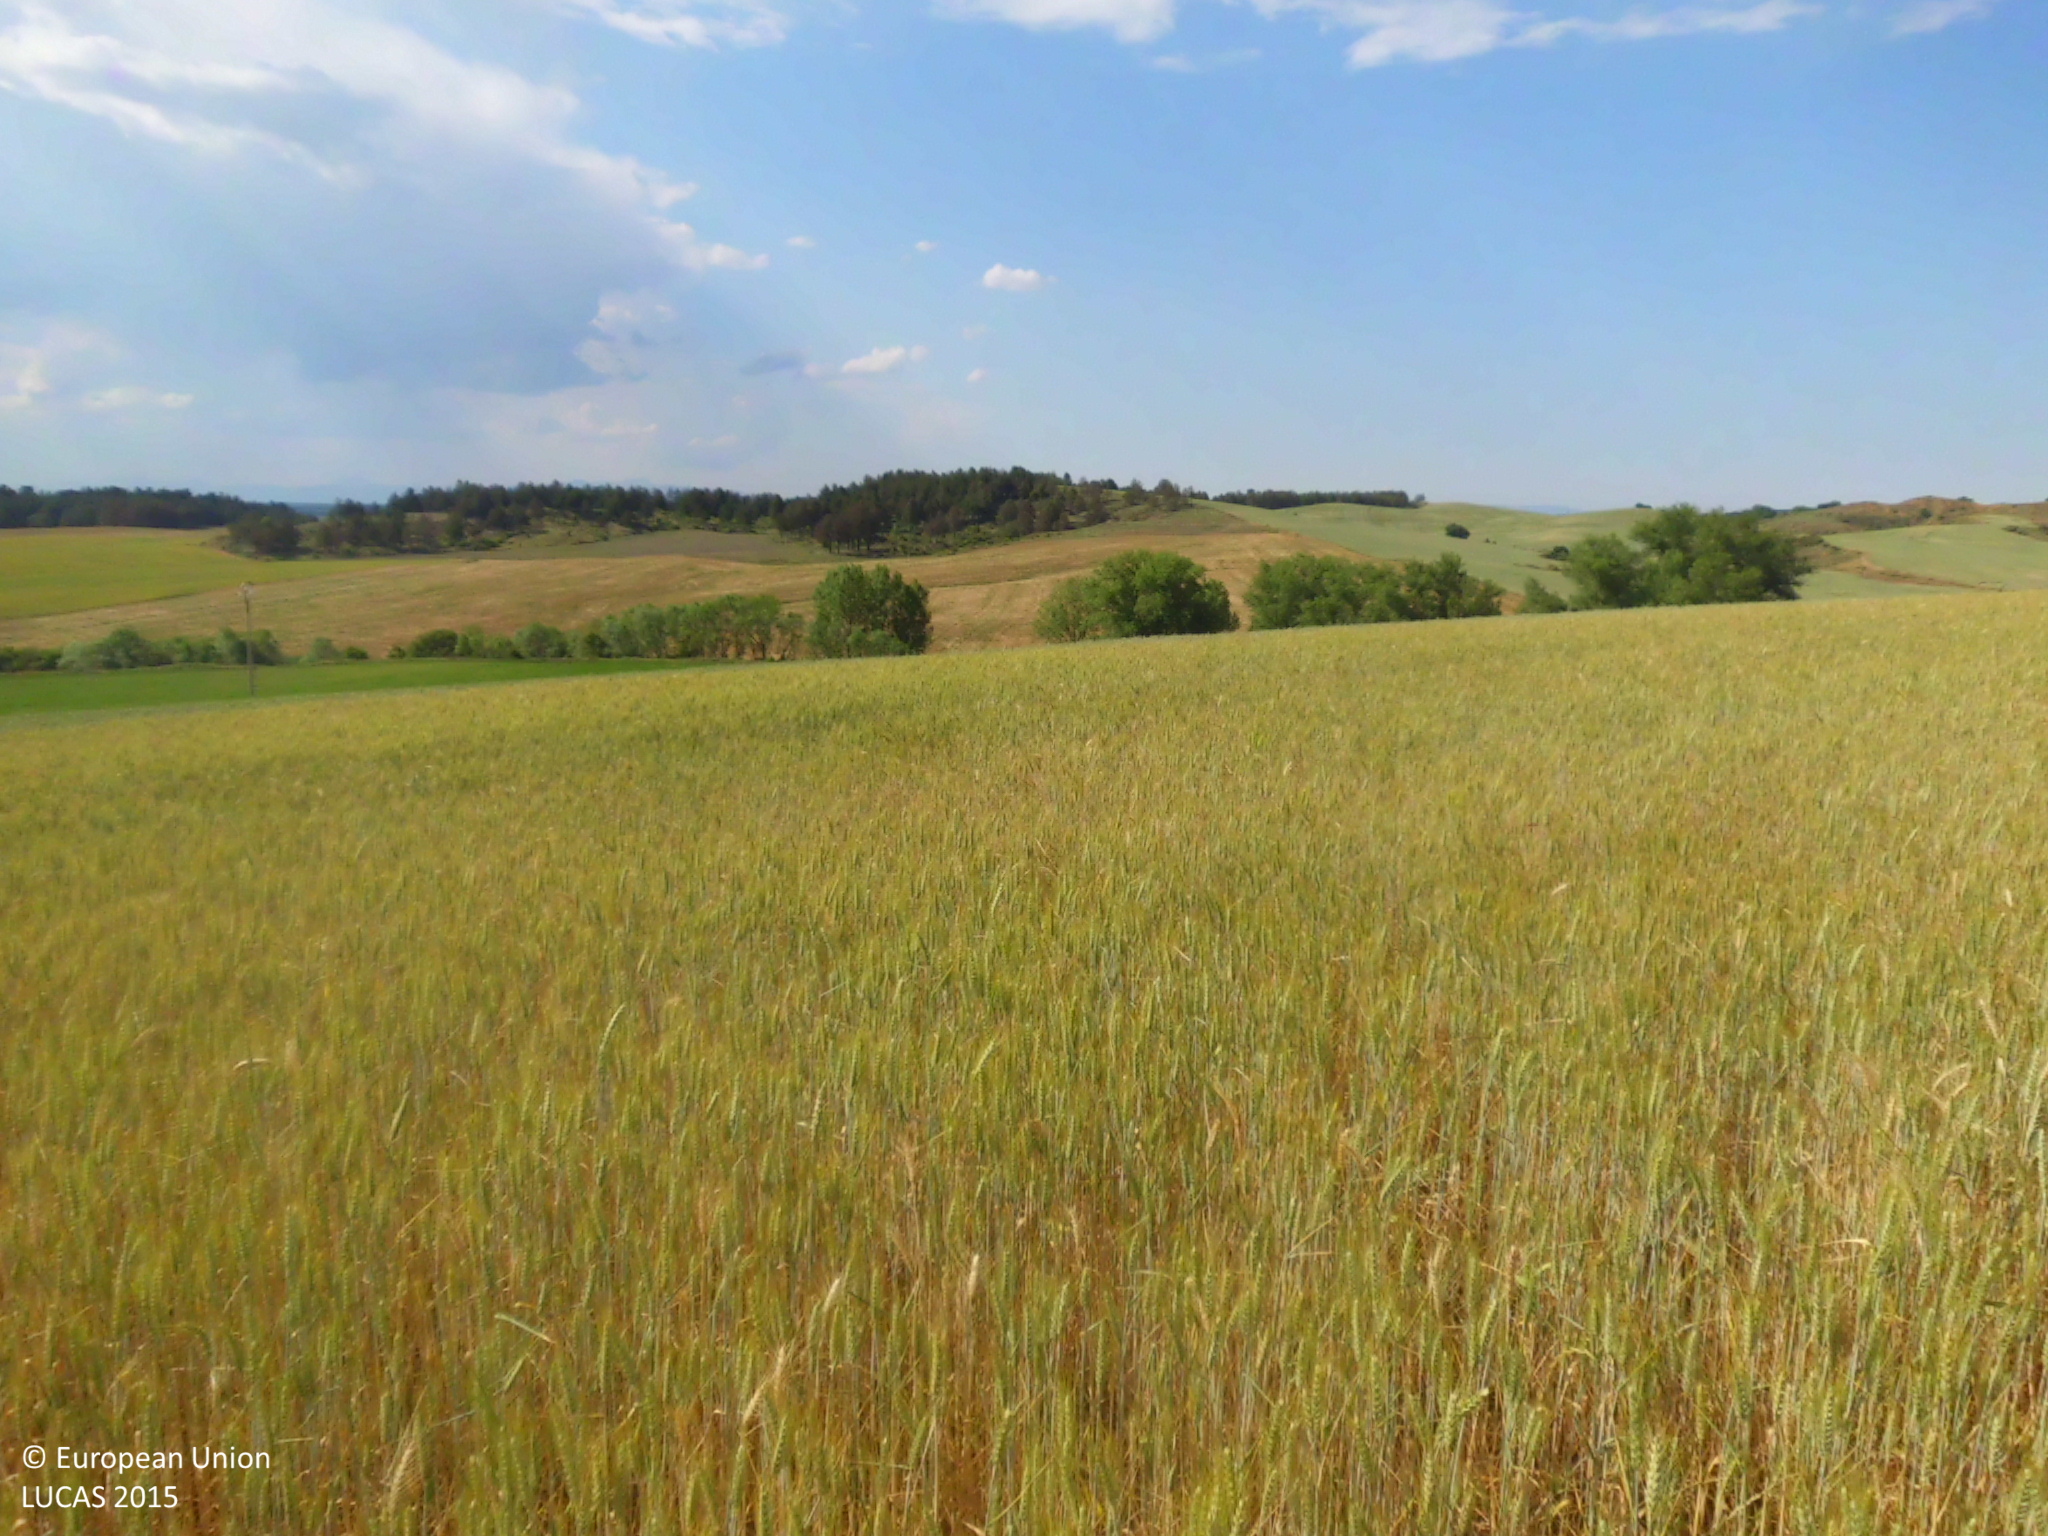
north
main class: Cropland
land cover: Common wheat
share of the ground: > 75 %
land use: Agriculture (excluding fallow land and kitchen gardens)
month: June
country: ES
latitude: 42.4878
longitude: -4.3434
